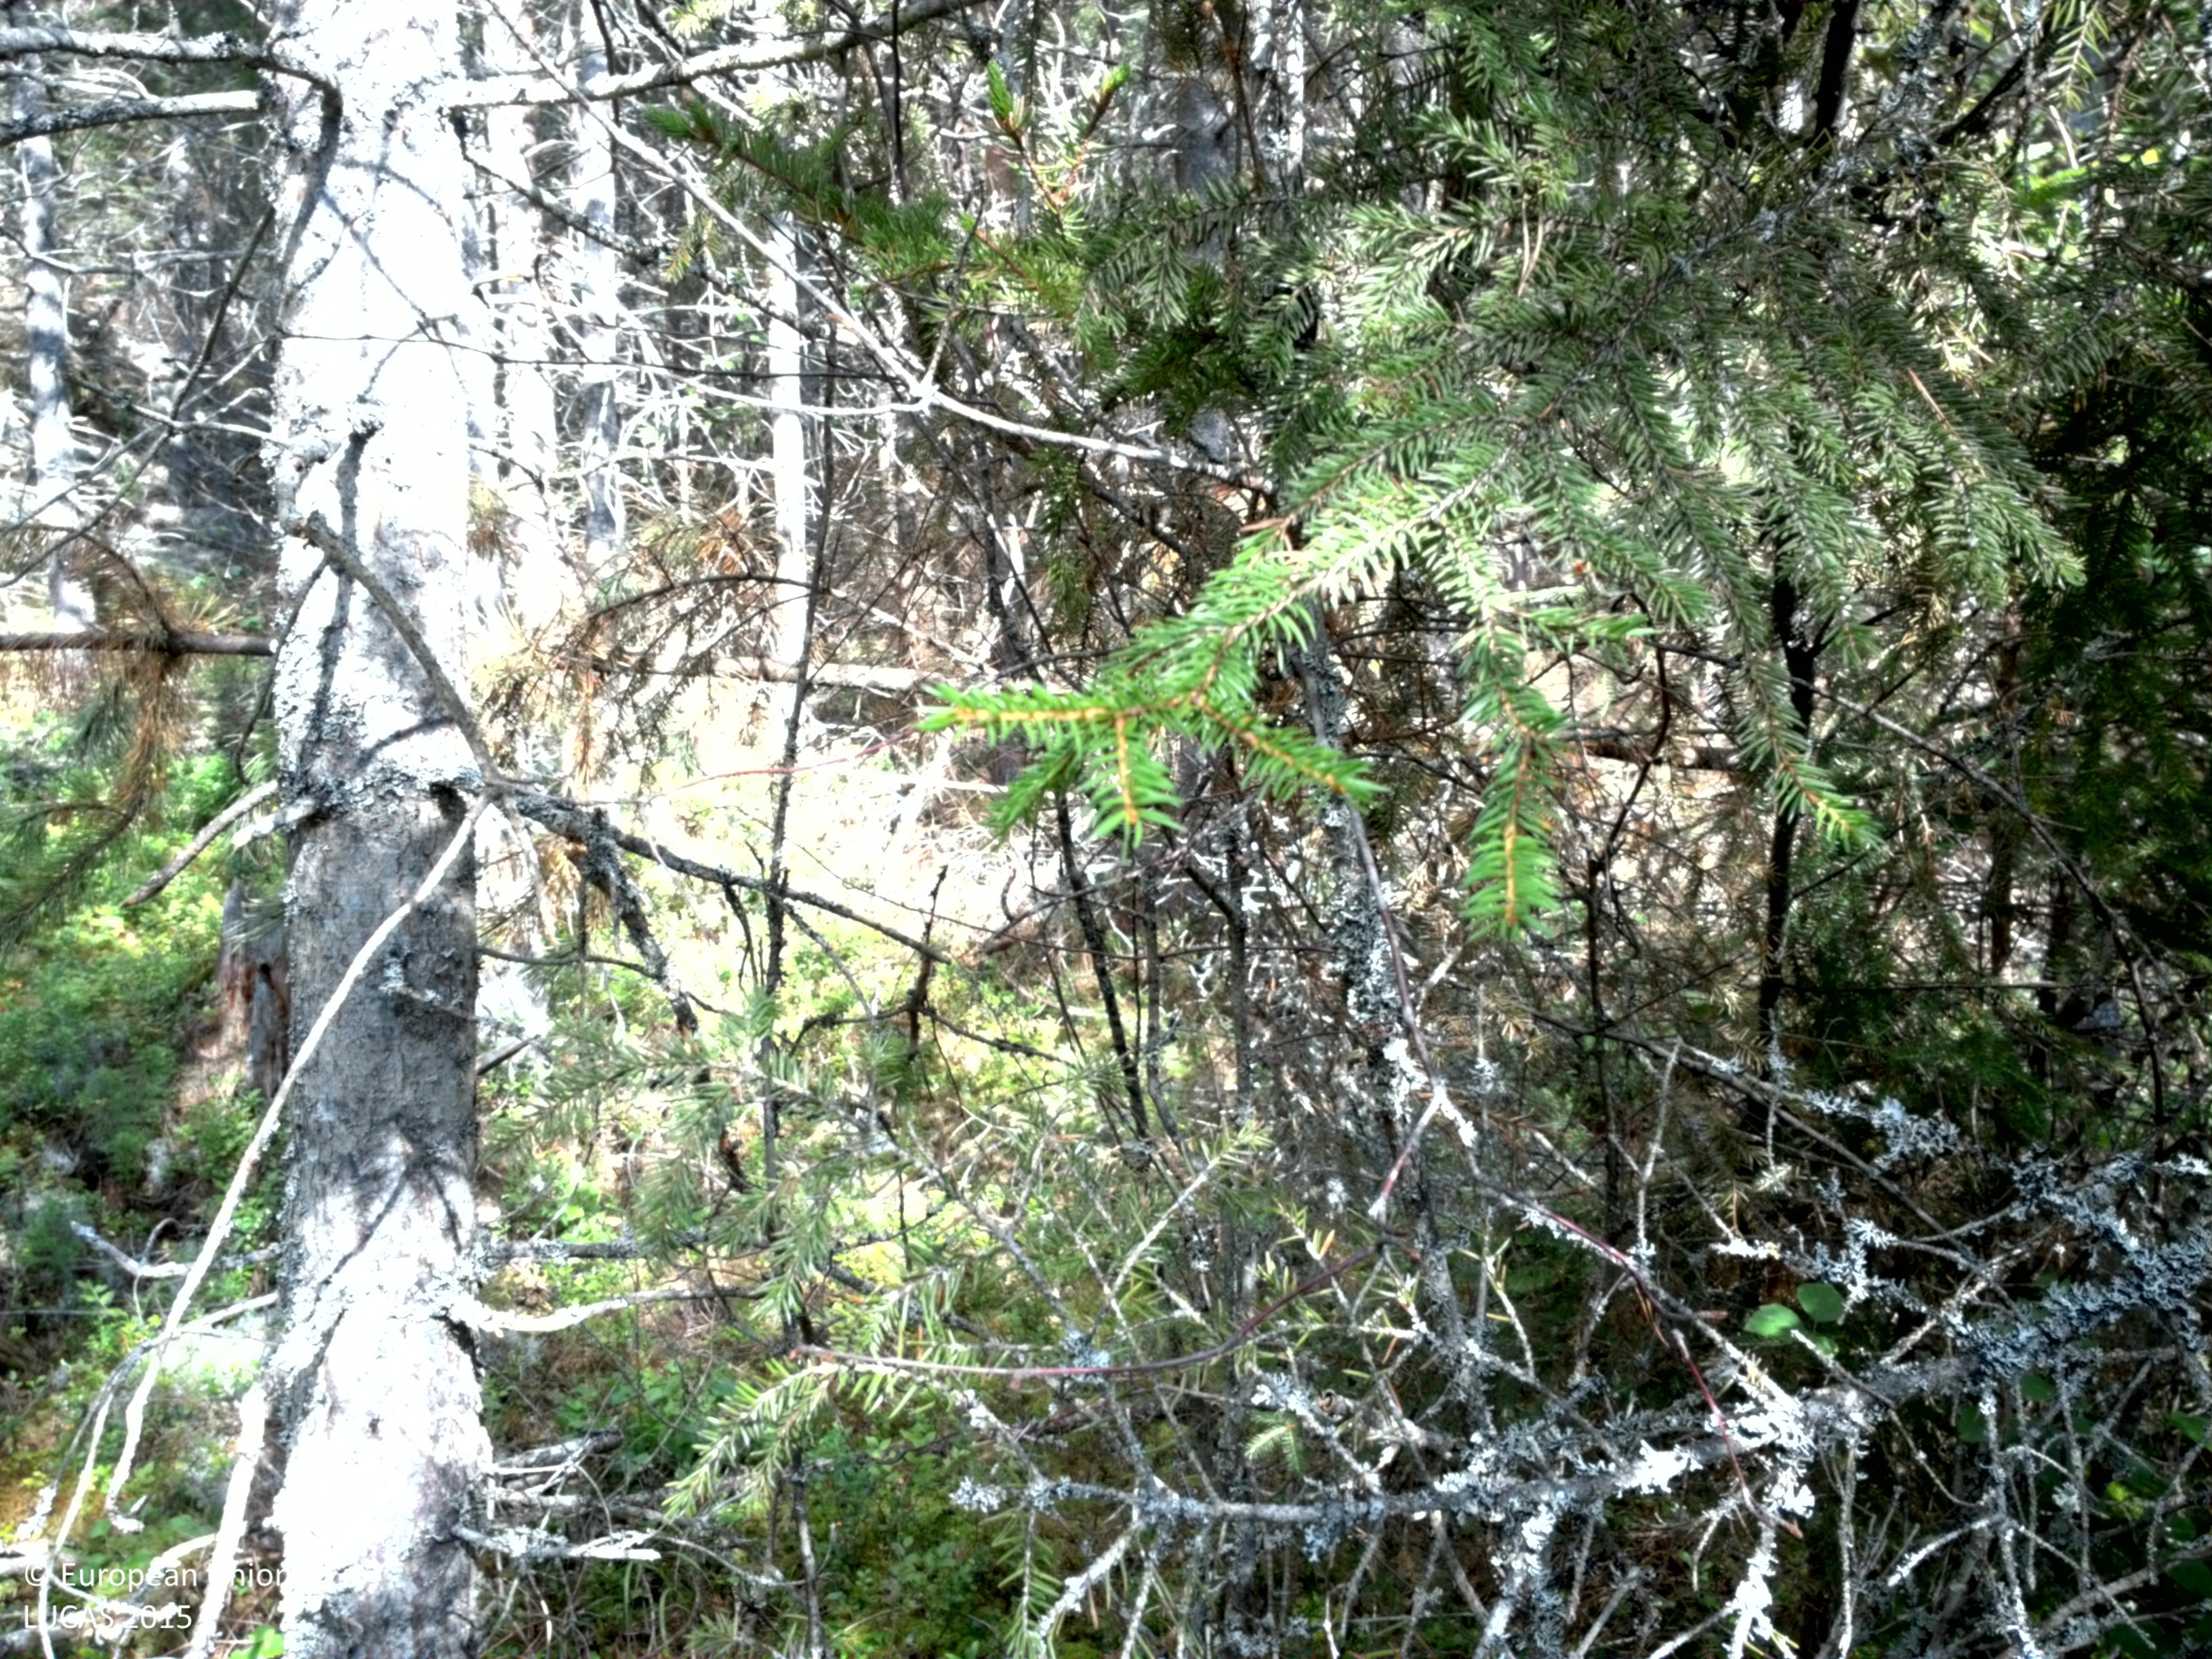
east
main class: Woodland
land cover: Other mixed woodland
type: boreal forest
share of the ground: > 75 %
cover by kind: coniferous forest trees 45 %, broadleaved forest trees 35 %, shrubs 10 %, herbaceous plants 5 %, lichens and mosses 5 %
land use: Forestry
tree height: > 5 m
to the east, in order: Other mixed woodland; Pine dominated coniferous woodland; Pine dominated mixed woodland; Spruce dominated mixed woodland; Tracks; Other mixed woodland; Pine dominated coniferous woodland
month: August
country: SE
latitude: 60.0627
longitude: 14.2472
